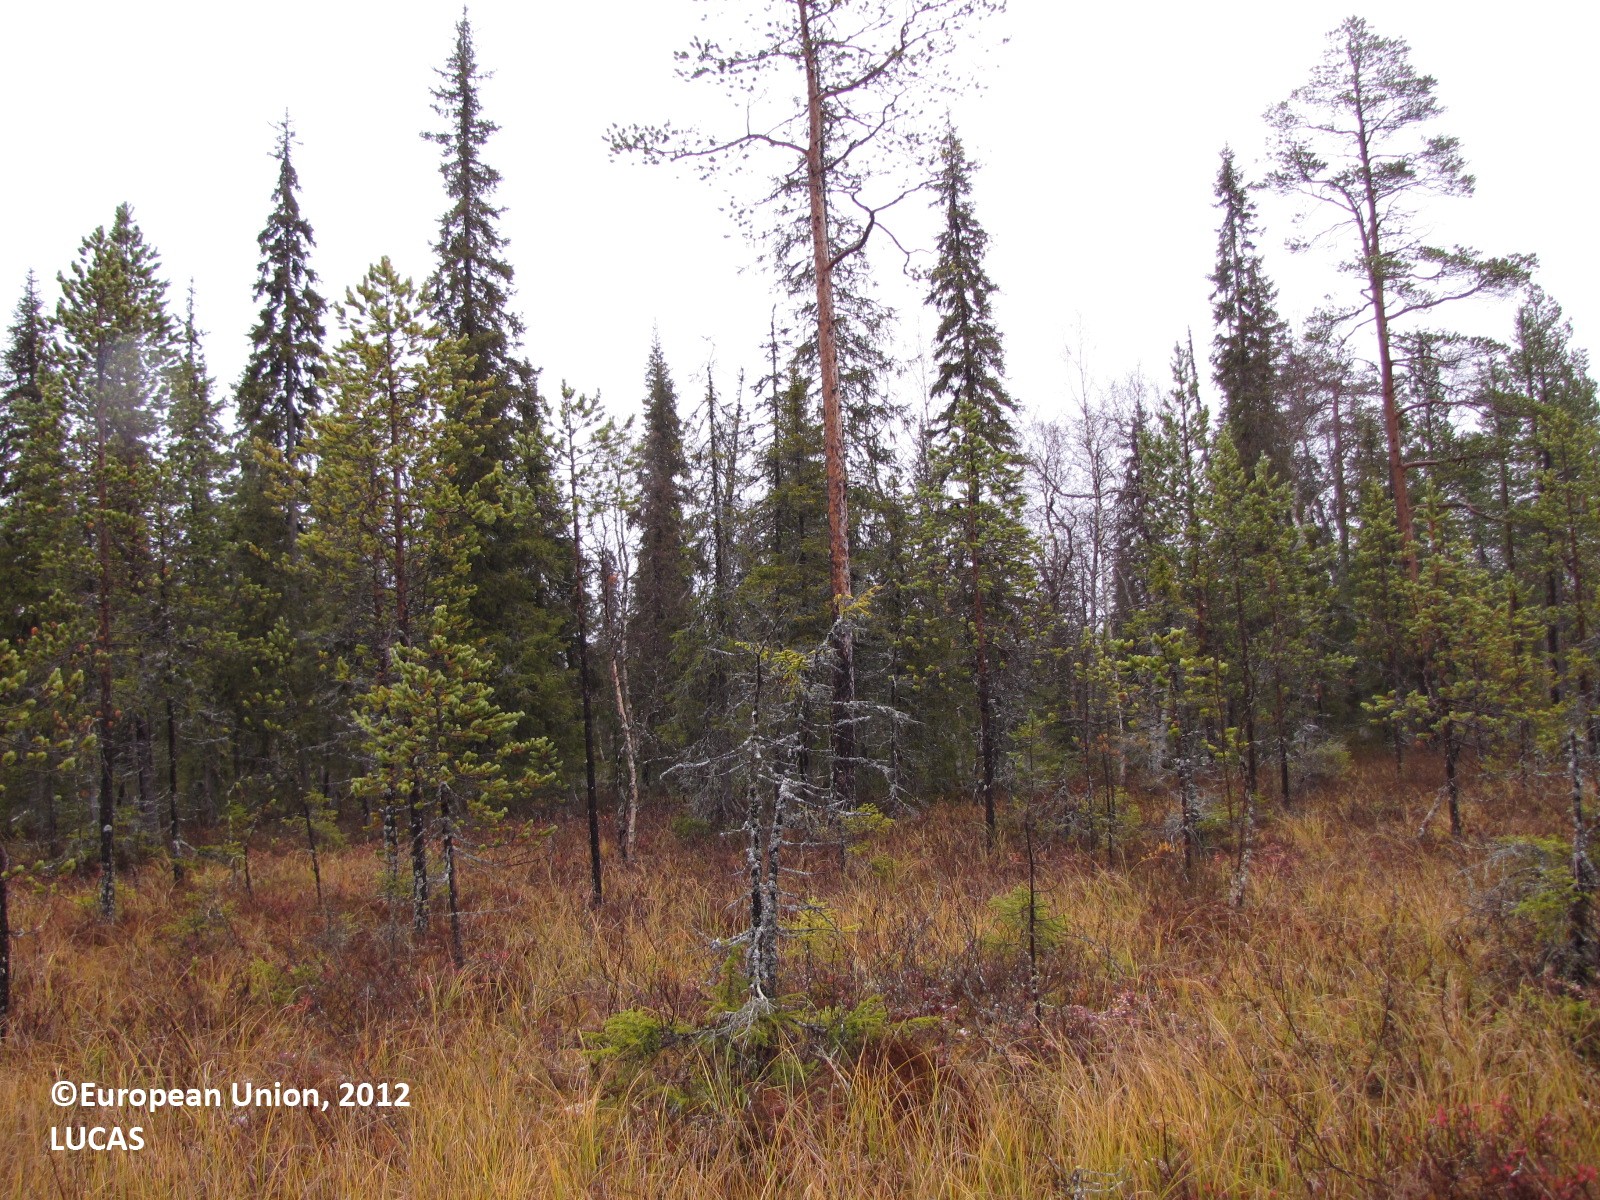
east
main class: Woodland
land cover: Pine dominated coniferous woodland
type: boreal forest
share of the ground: 10 - 25 %
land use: Forestry
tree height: < 5 m
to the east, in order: Pine dominated coniferous woodland; Spruce dominated mixed woodland; Rivers and streams; Spruce dominated mixed woodland; Grassland with sparse tree/shrub cover; Pine dominated mixed woodland; Ditches and canals; Grass margins; Paved roads, cycling and walking lanes; Shruby margins; Ditches and canals; Pine dominated mixed woodland; Ditches and canals; Spruce dominated mixed woodland
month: September
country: FI
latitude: 67.7147
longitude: 23.6017
